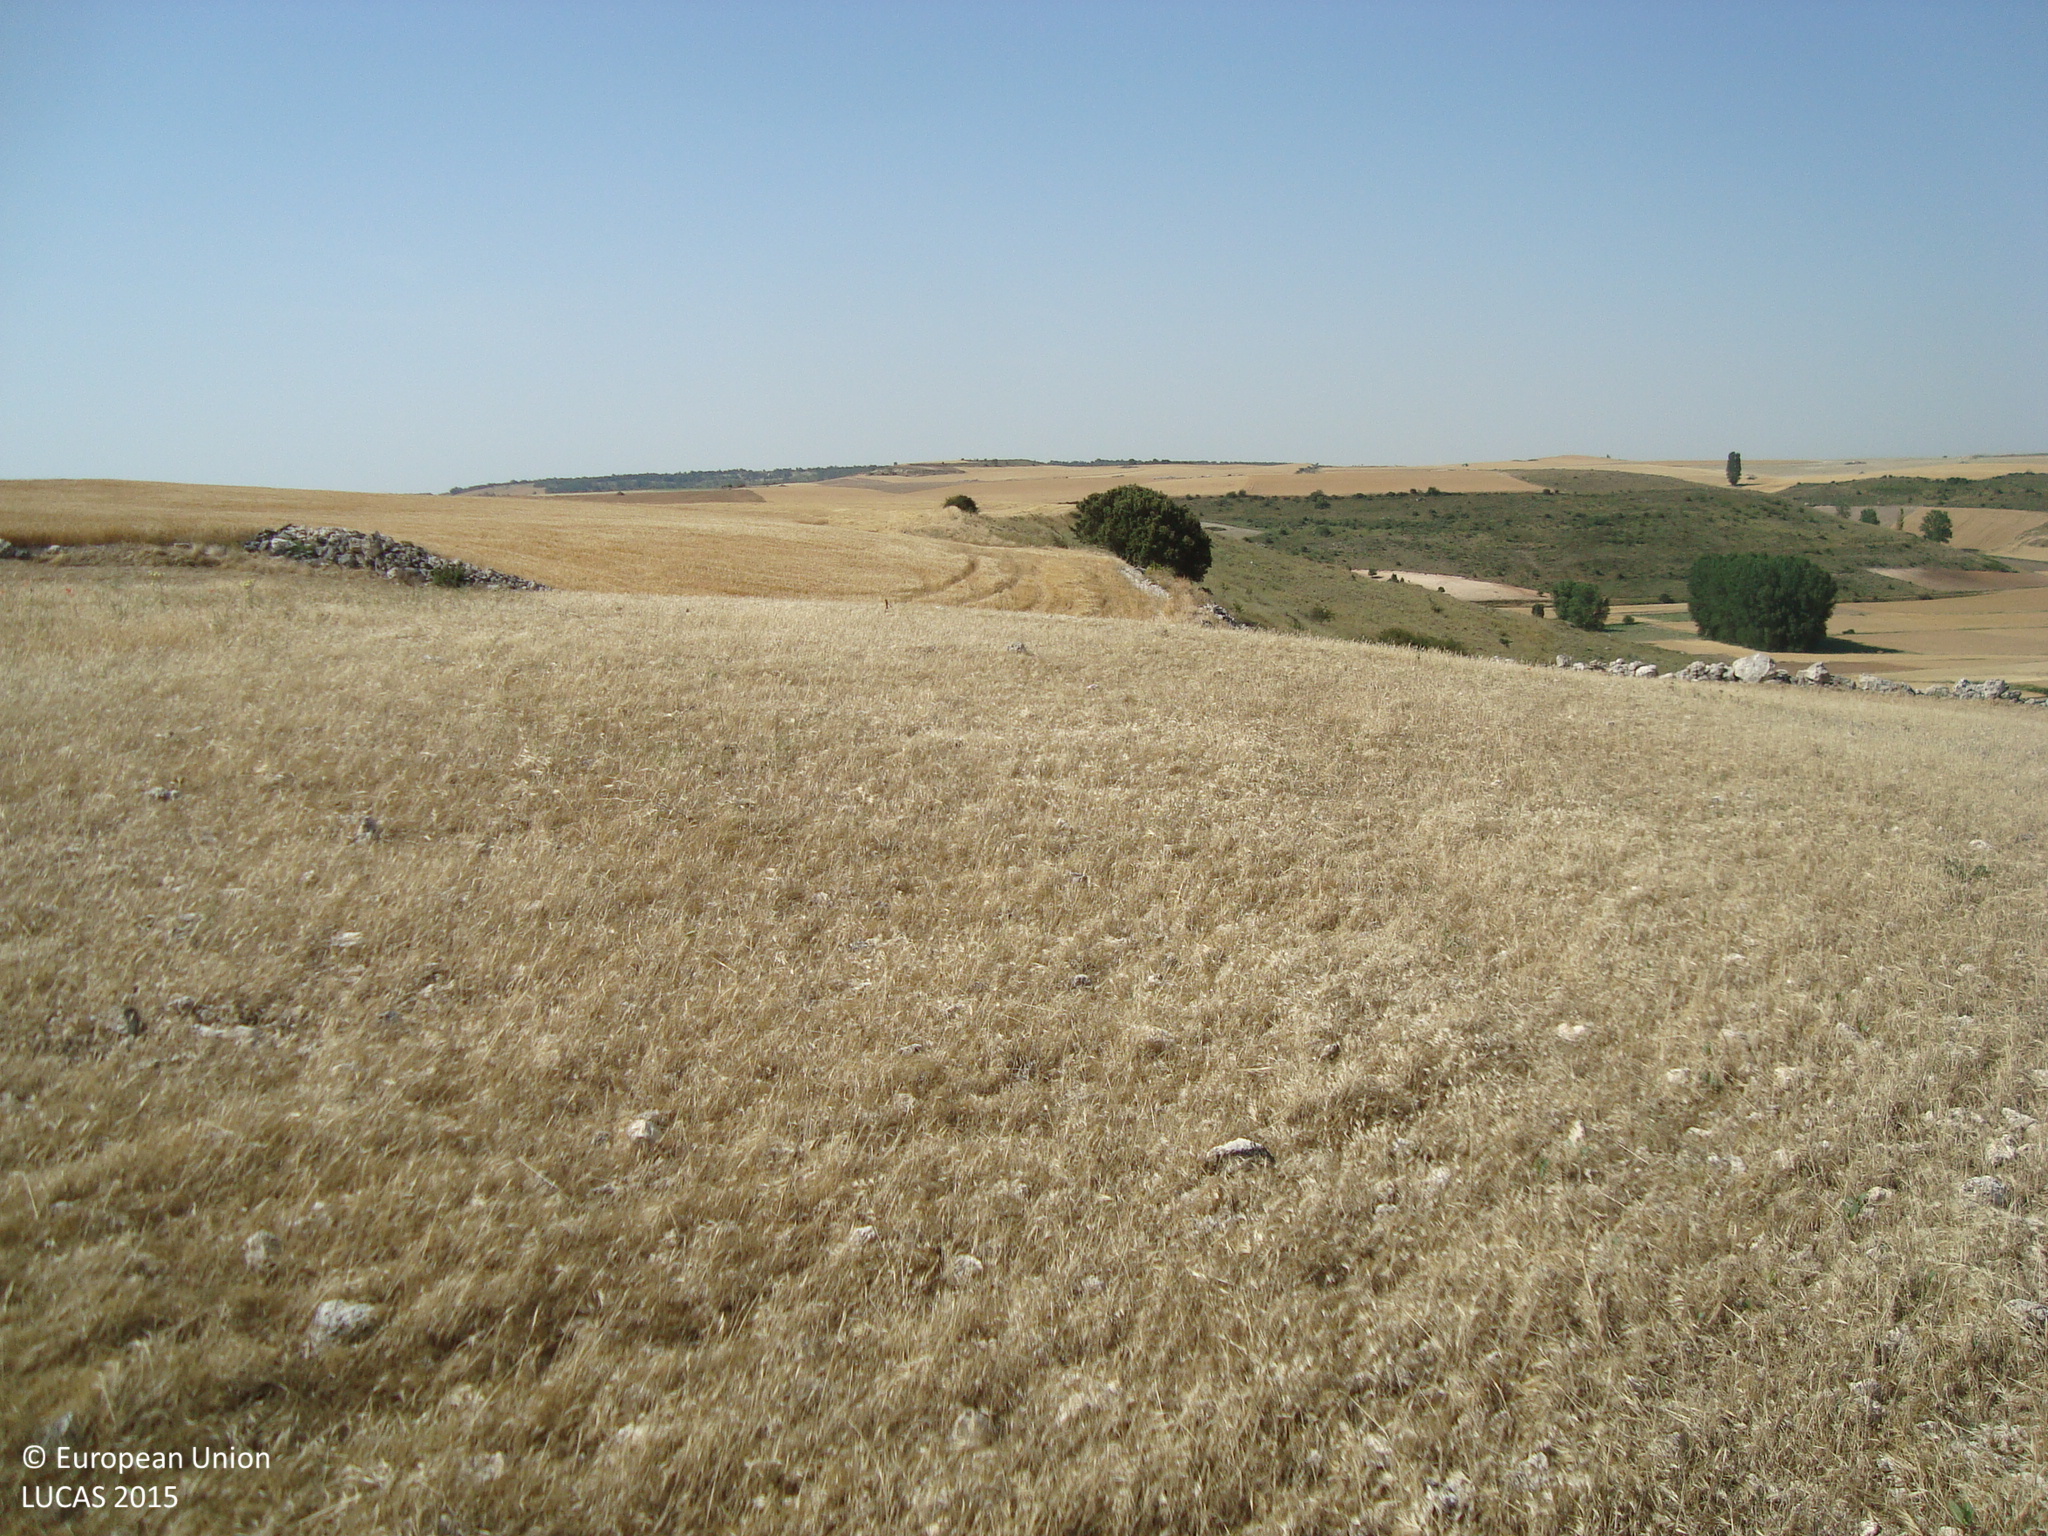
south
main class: Grassland
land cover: Grassland without tree/shrub cover
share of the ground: > 75 %
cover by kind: herbaceous plants 90 %, unconsolidated bare surface 10 %
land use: Abandoned areas
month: July
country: ES
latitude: 41.8409
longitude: -3.8706
